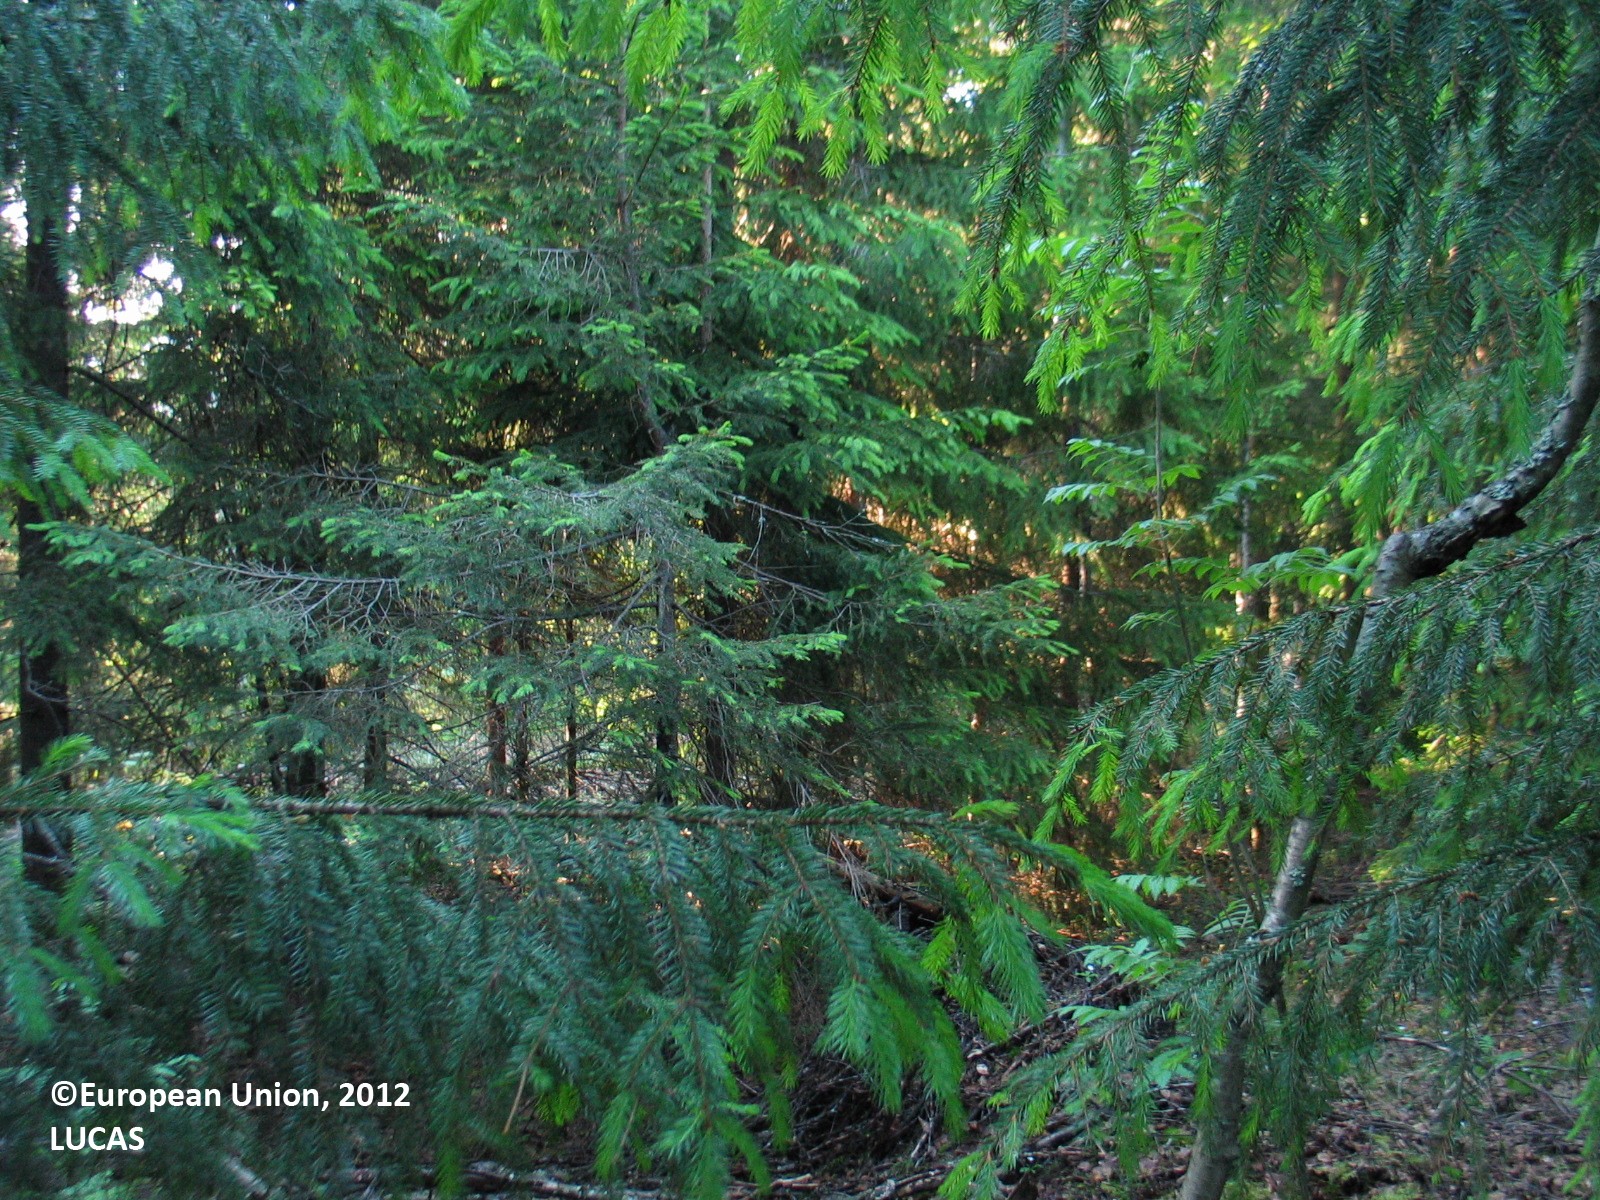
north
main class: Woodland
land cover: Spruce dominated coniferous woodland
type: boreal forest
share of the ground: 50 - 75 %
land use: Forestry
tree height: > 5 m
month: June
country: FI
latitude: 65.1290
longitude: 25.4886
